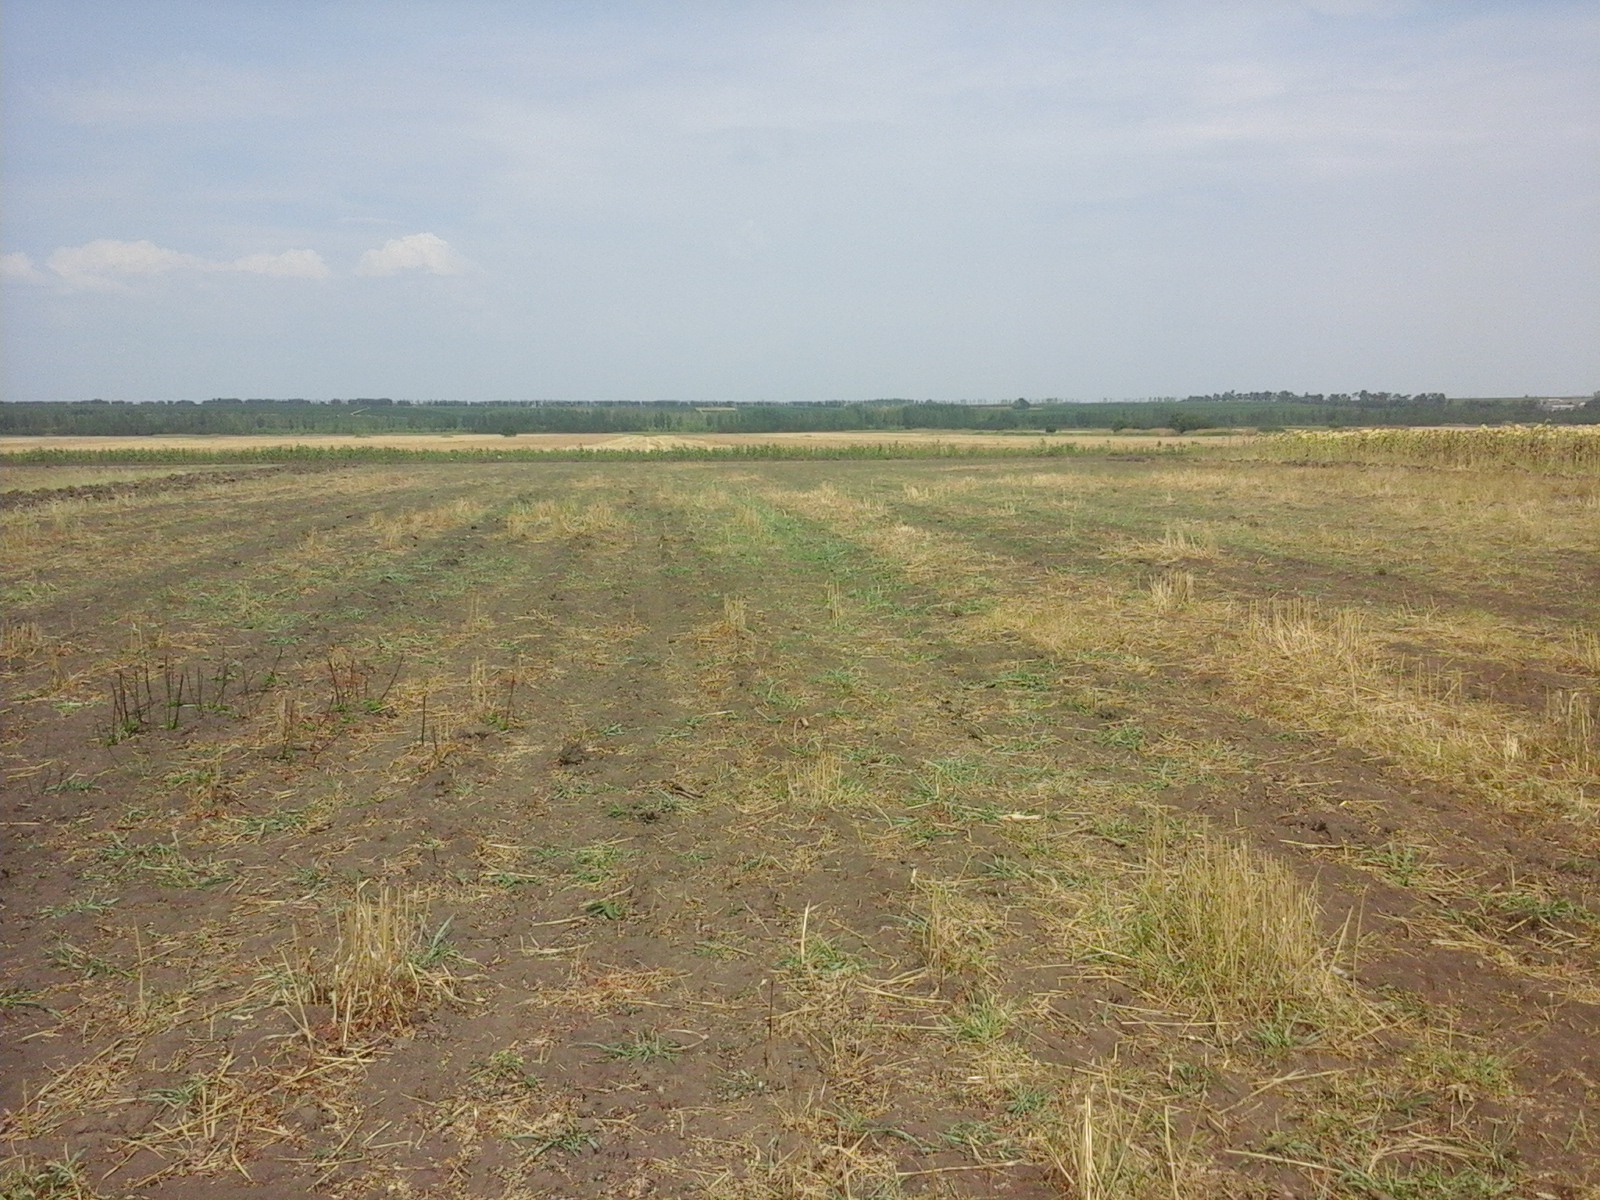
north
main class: Cropland
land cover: Common wheat
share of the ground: 25 - 50 %
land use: Agriculture (excluding fallow land and kitchen gardens)
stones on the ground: < 10 %
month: August
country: RO
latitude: 44.0941
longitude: 23.7055
